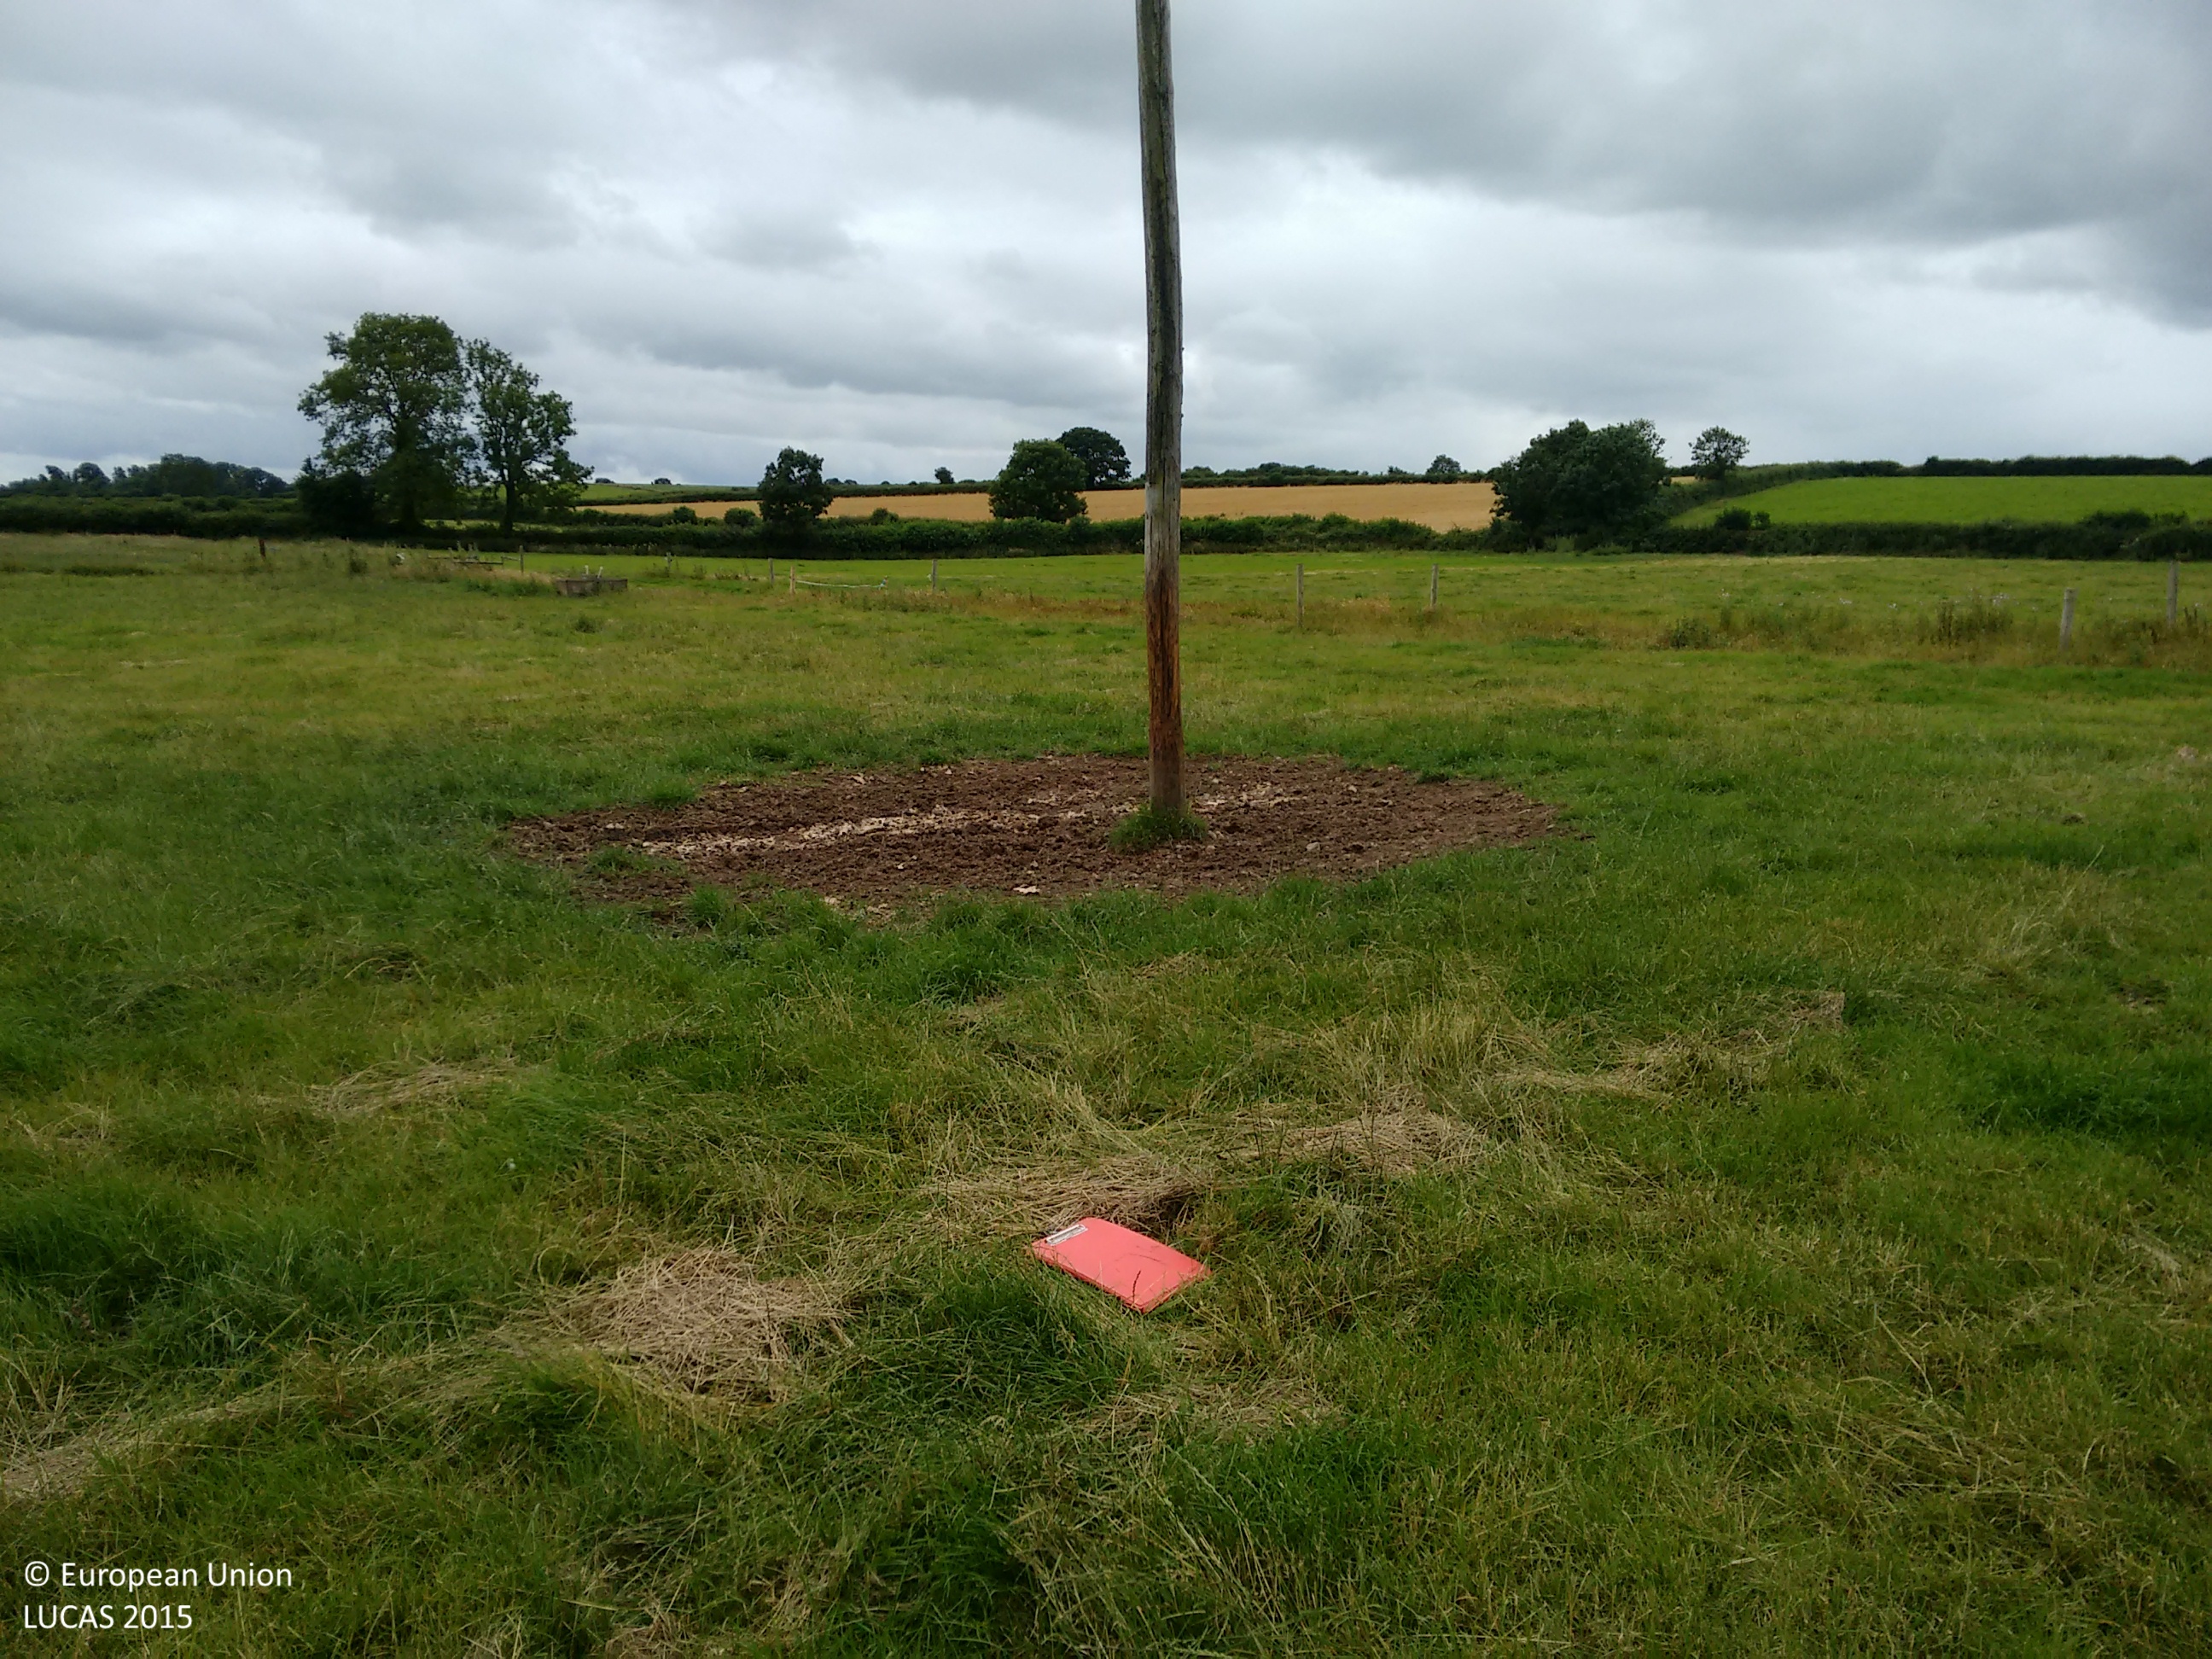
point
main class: Grassland
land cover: Grassland without tree/shrub cover
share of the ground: > 75 %
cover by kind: herbaceous plants 95 %, unconsolidated bare surface 5 %
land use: Agriculture (excluding fallow land and kitchen gardens)
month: July
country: IE
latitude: 52.6600
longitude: -7.2873
